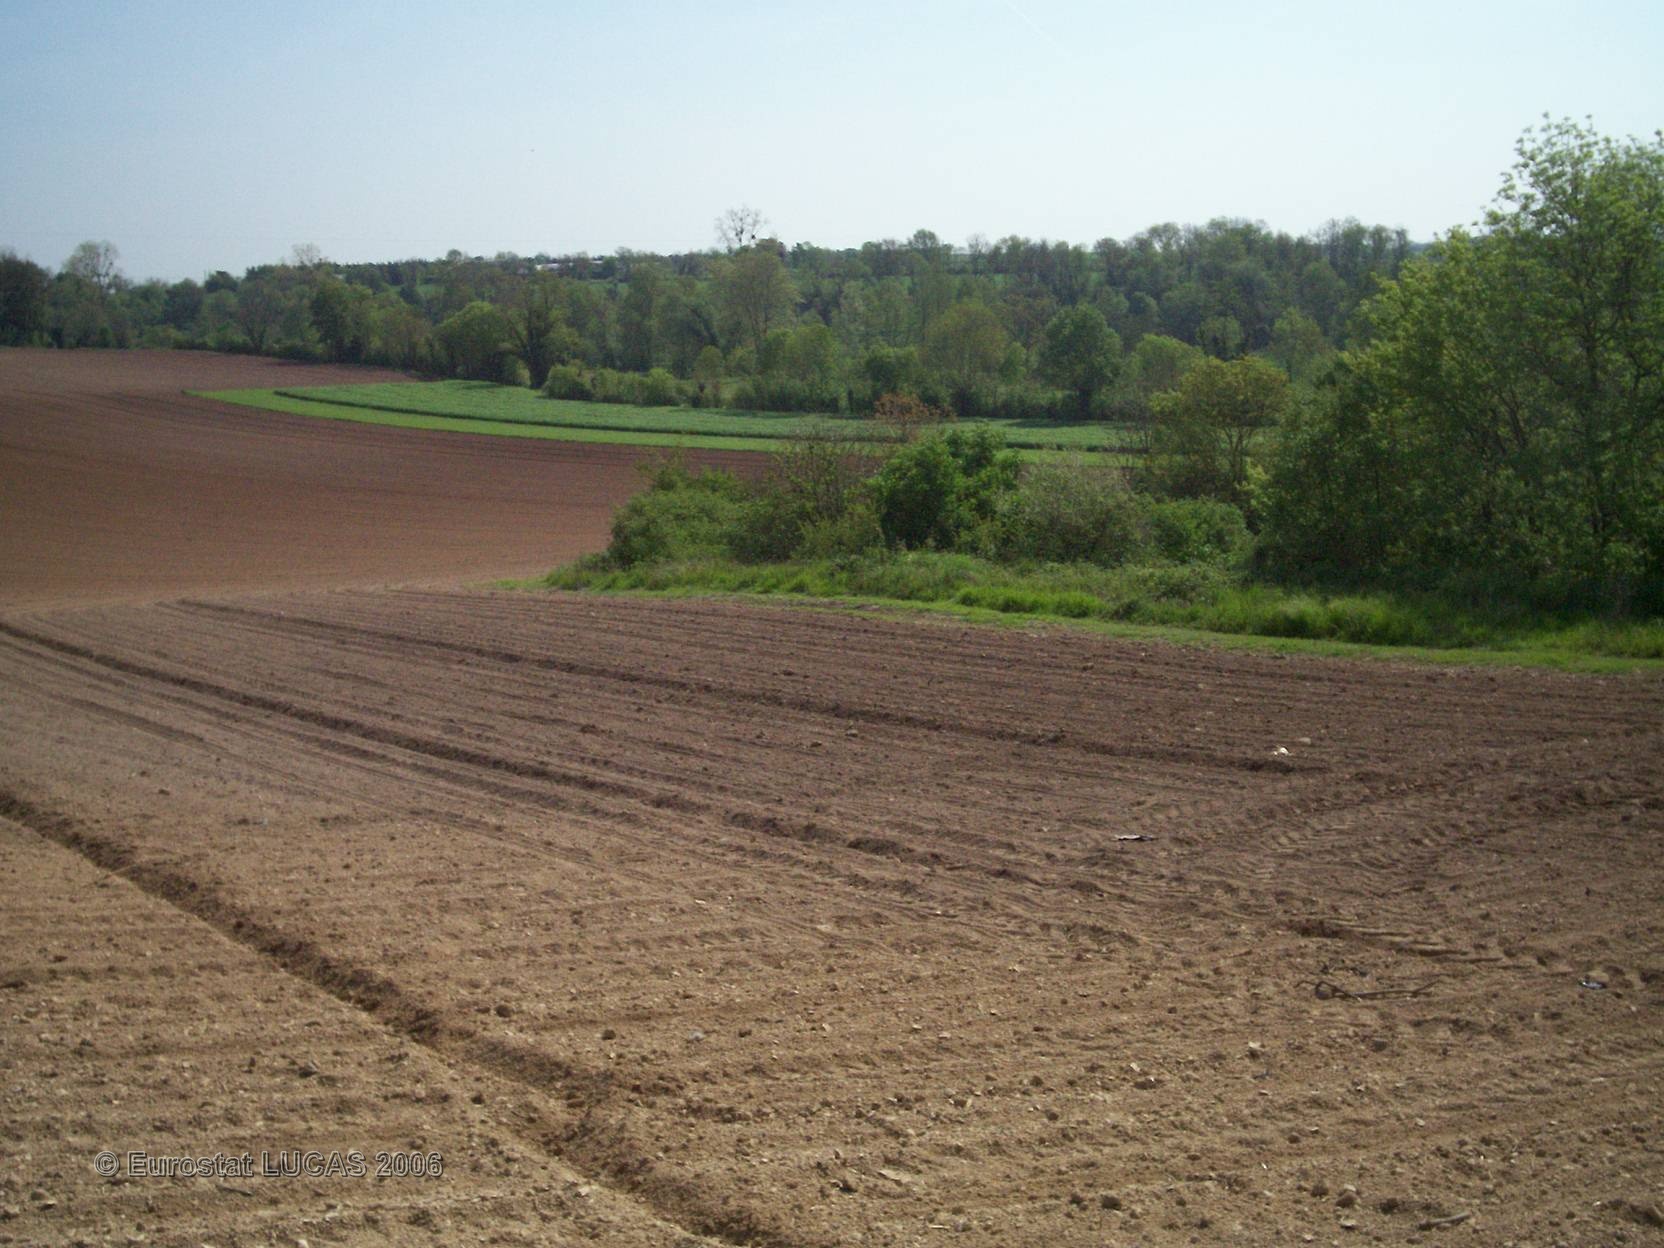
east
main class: Cropland
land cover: Sunflower
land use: Agriculture (excluding fallow land and kitchen gardens)
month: May
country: FR
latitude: 46.2026
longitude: -0.2479
